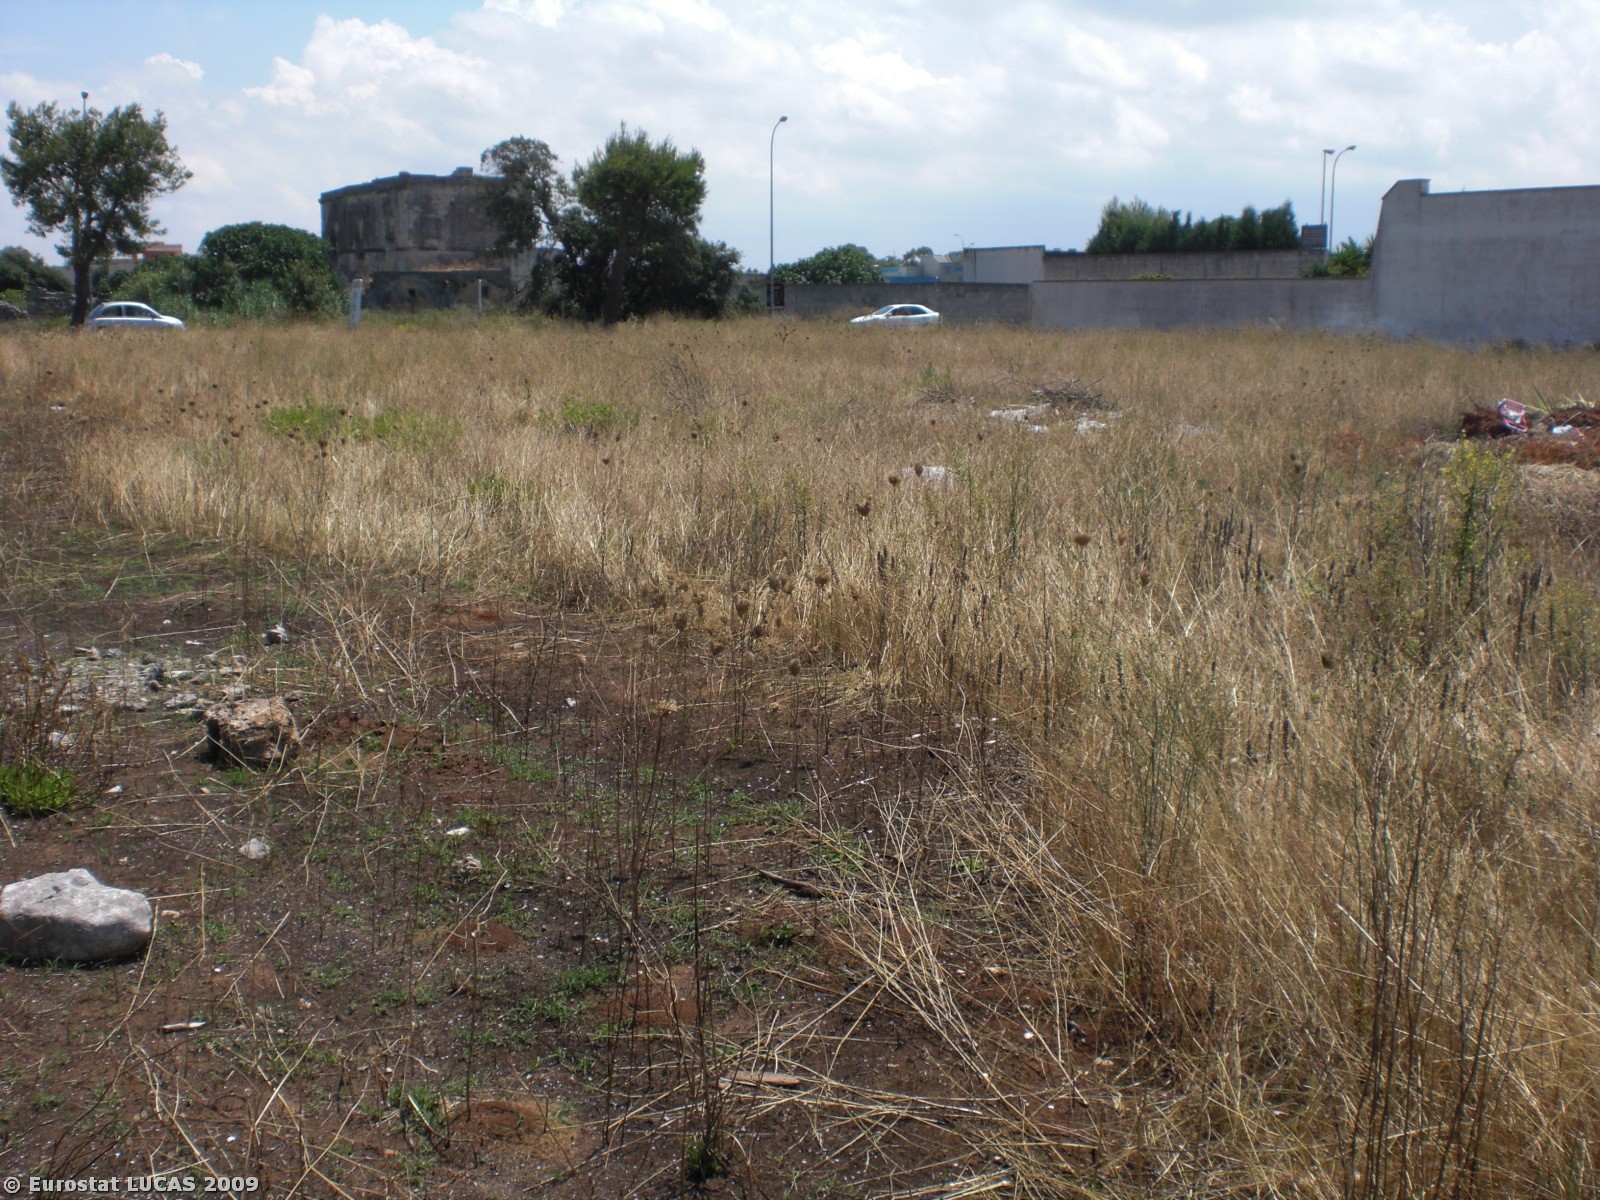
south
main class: Grassland
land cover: Spontaneously vegetated surfaces
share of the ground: > 75 %
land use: Fallow land
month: June
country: IT
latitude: 40.3832
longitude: 18.1386
